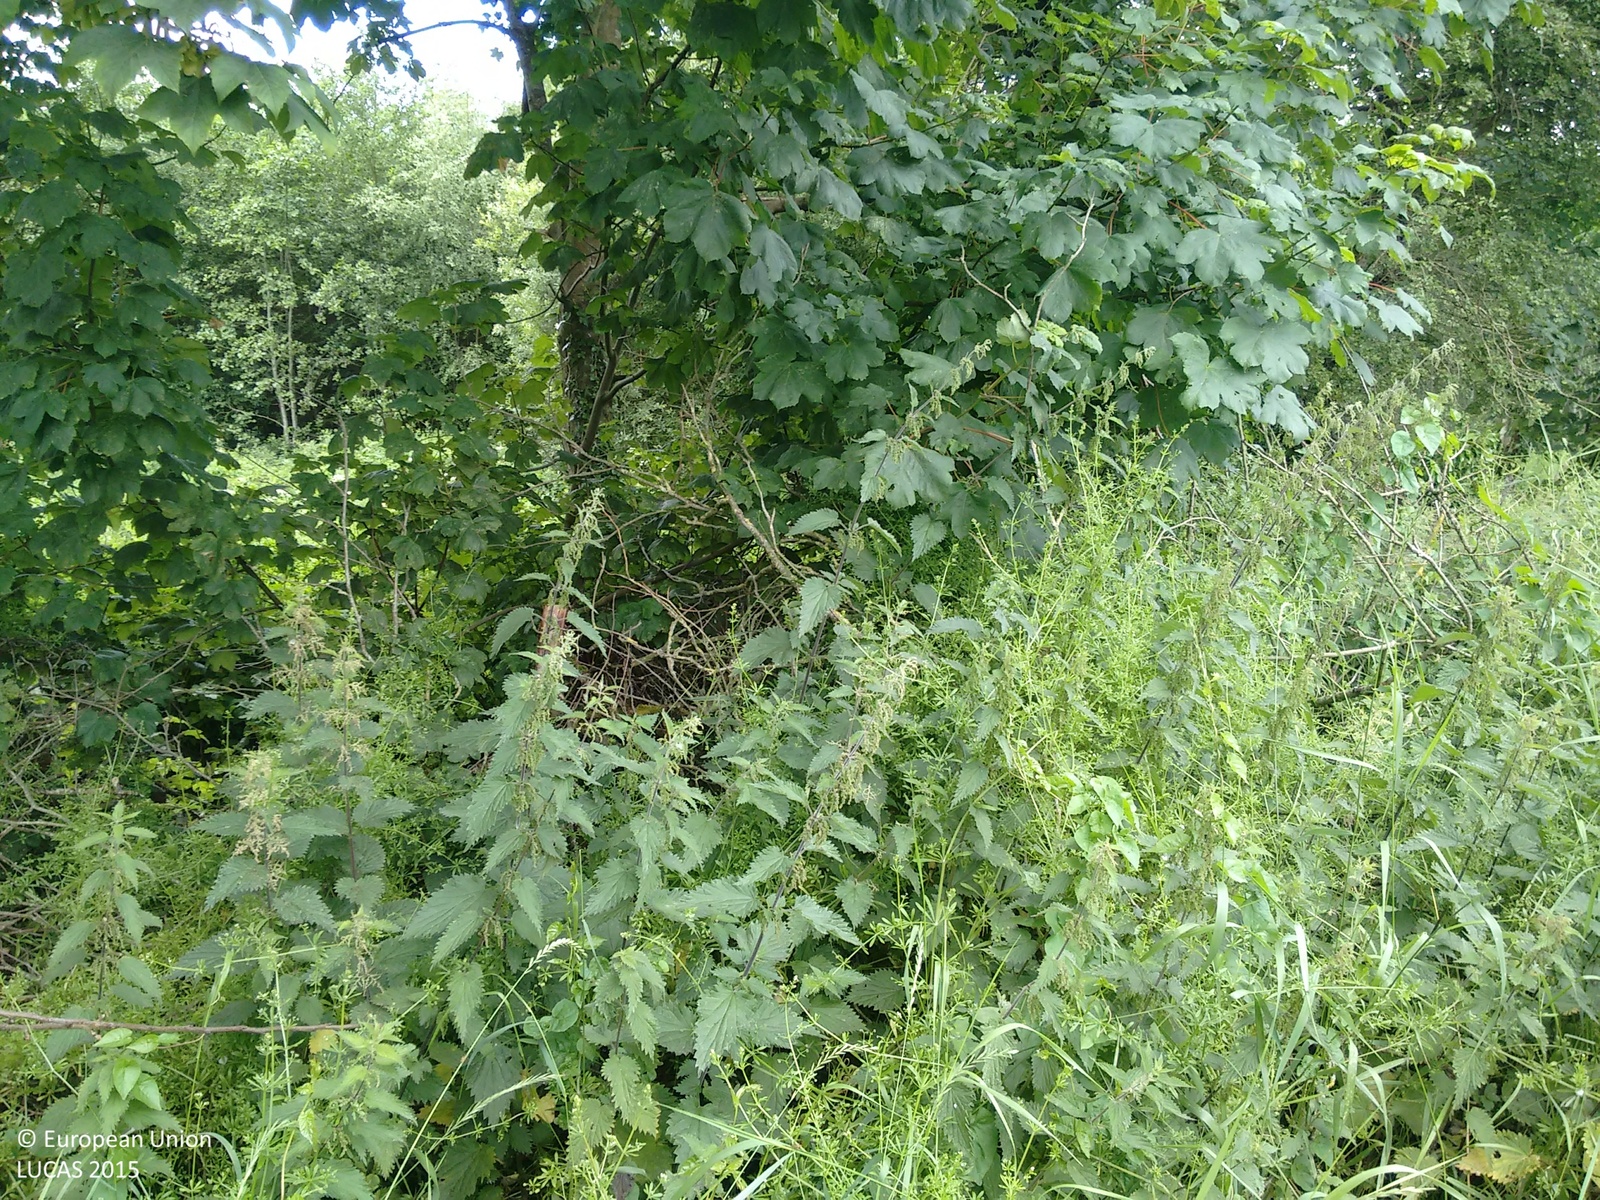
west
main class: Woodland
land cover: Broadleaved woodland
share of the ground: > 75 %
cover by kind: broadleaved forest trees 90 %, shrubs 10 %
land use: Semi-natural and natural areas not in use
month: July
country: IE
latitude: 53.4764
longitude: -7.7498
